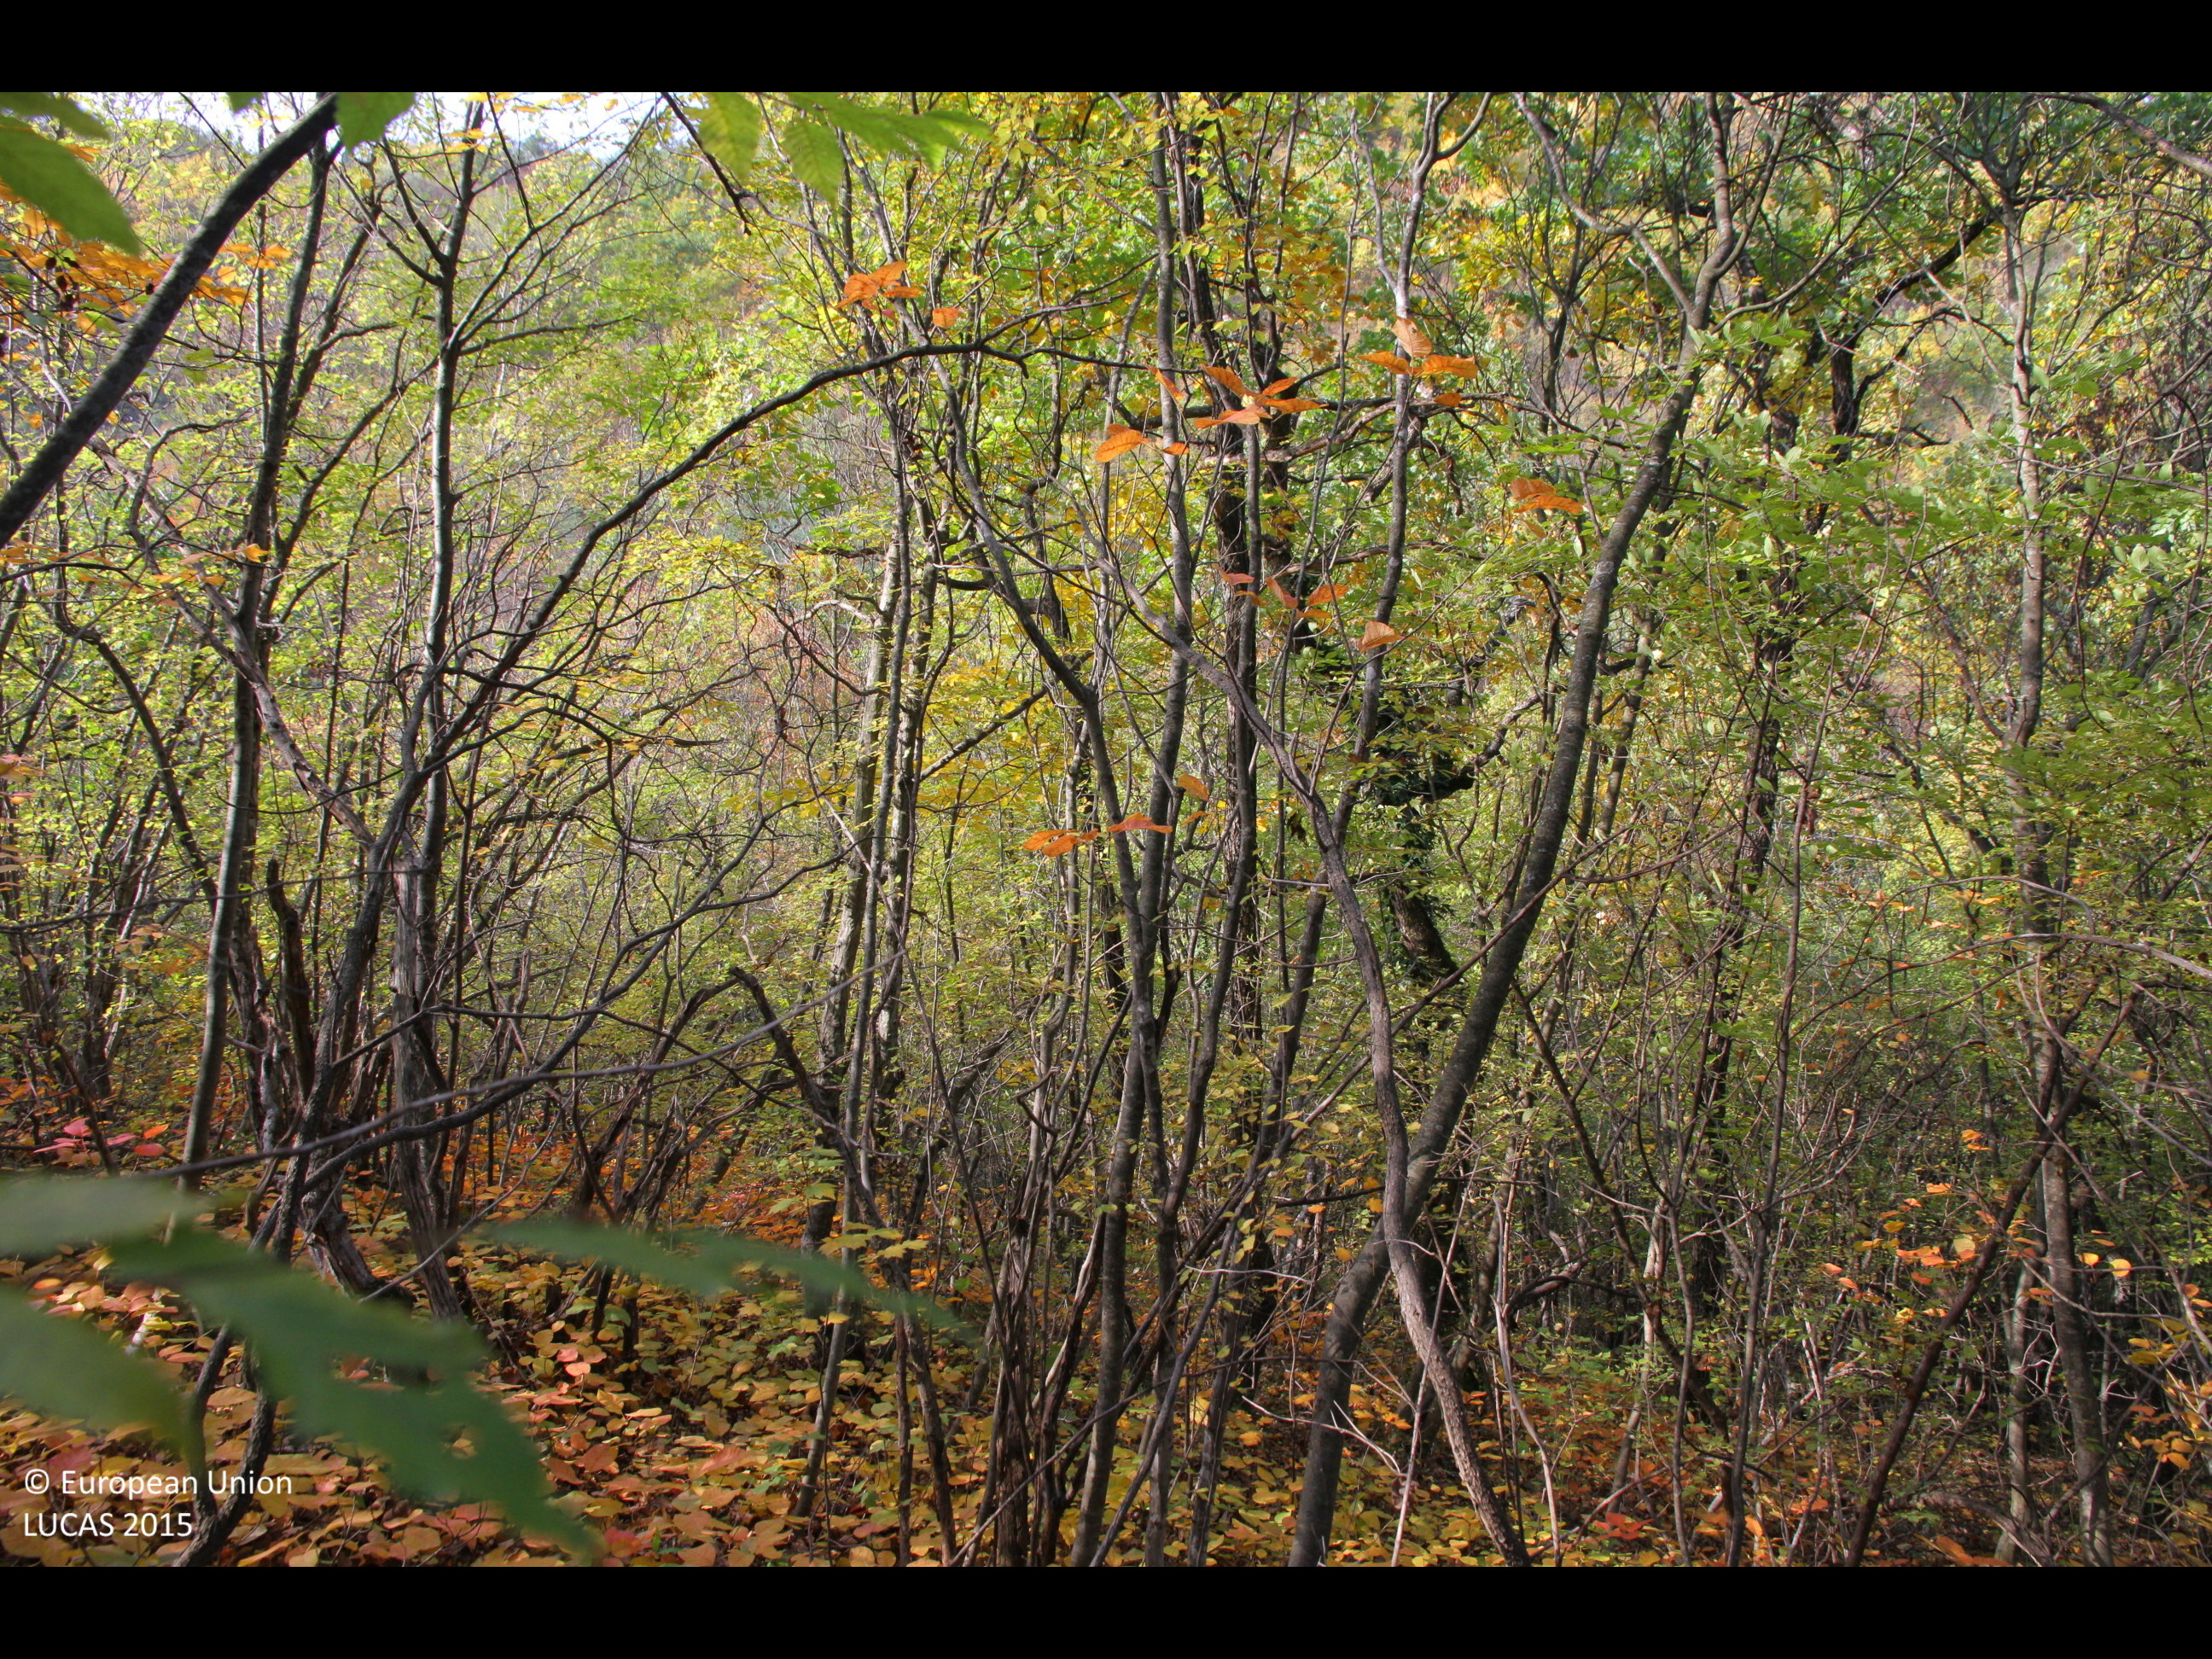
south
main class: Woodland
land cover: Broadleaved woodland
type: mesophytic deciduous forest
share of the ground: > 75 %
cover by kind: broadleaved forest trees 100 %
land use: Forestry
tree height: > 5 m
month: October
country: BG
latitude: 43.1320
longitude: 26.8144
